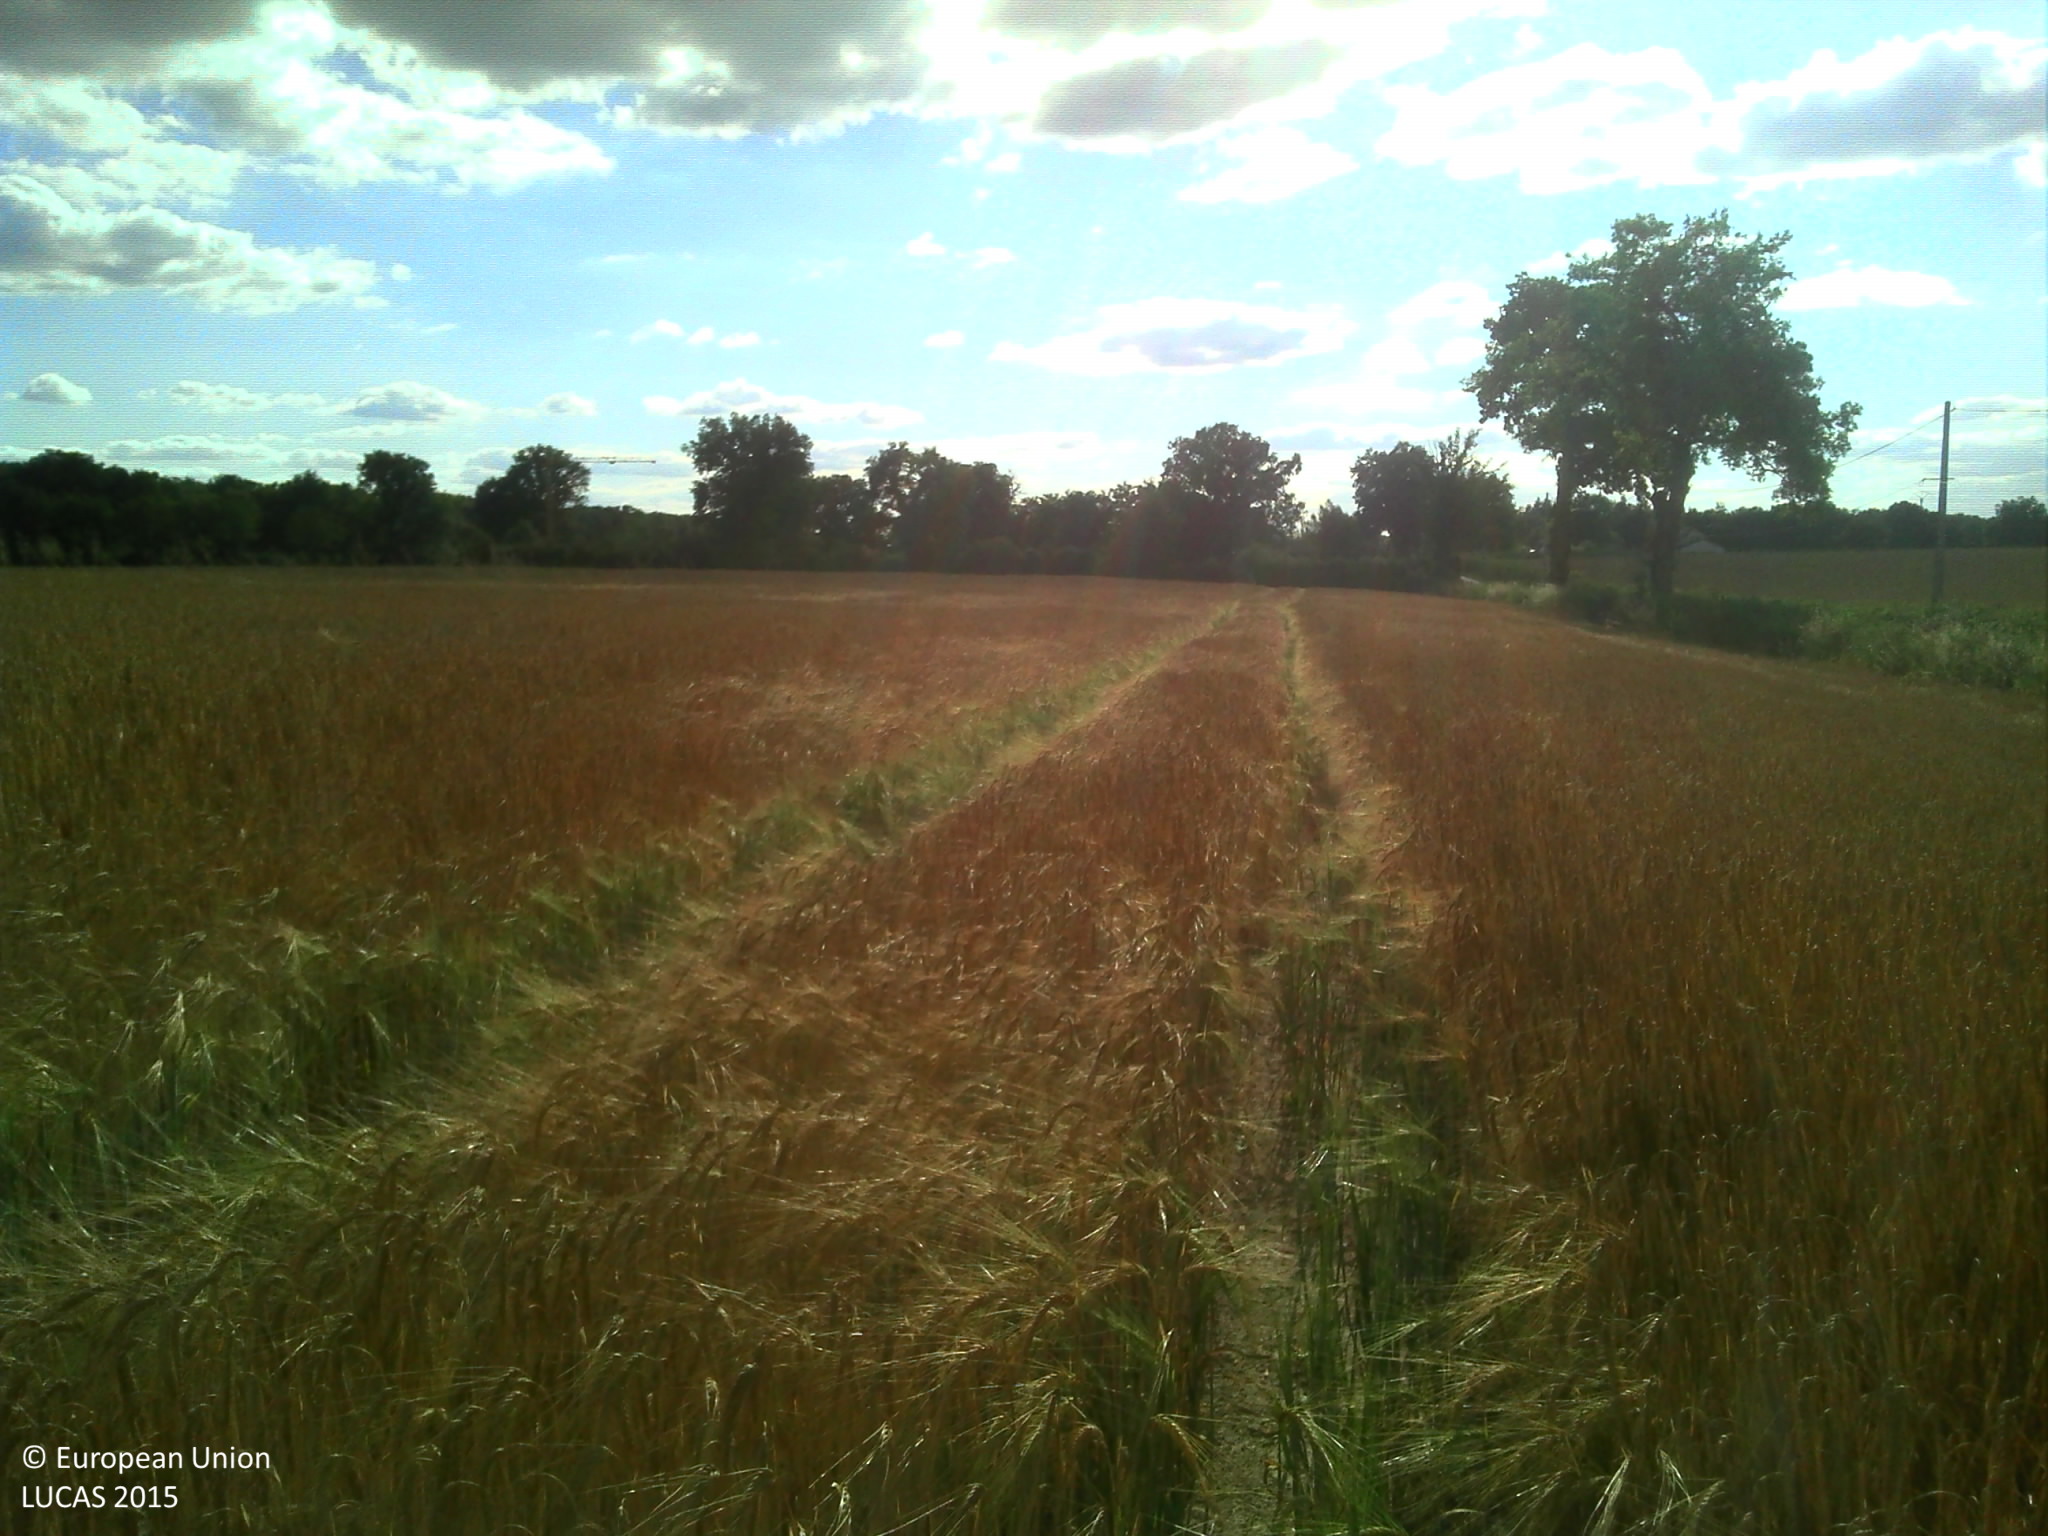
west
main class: Cropland
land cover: Barley
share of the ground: > 75 %
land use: Agriculture (excluding fallow land and kitchen gardens)
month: June
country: FR
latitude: 46.4220
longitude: 4.0803
